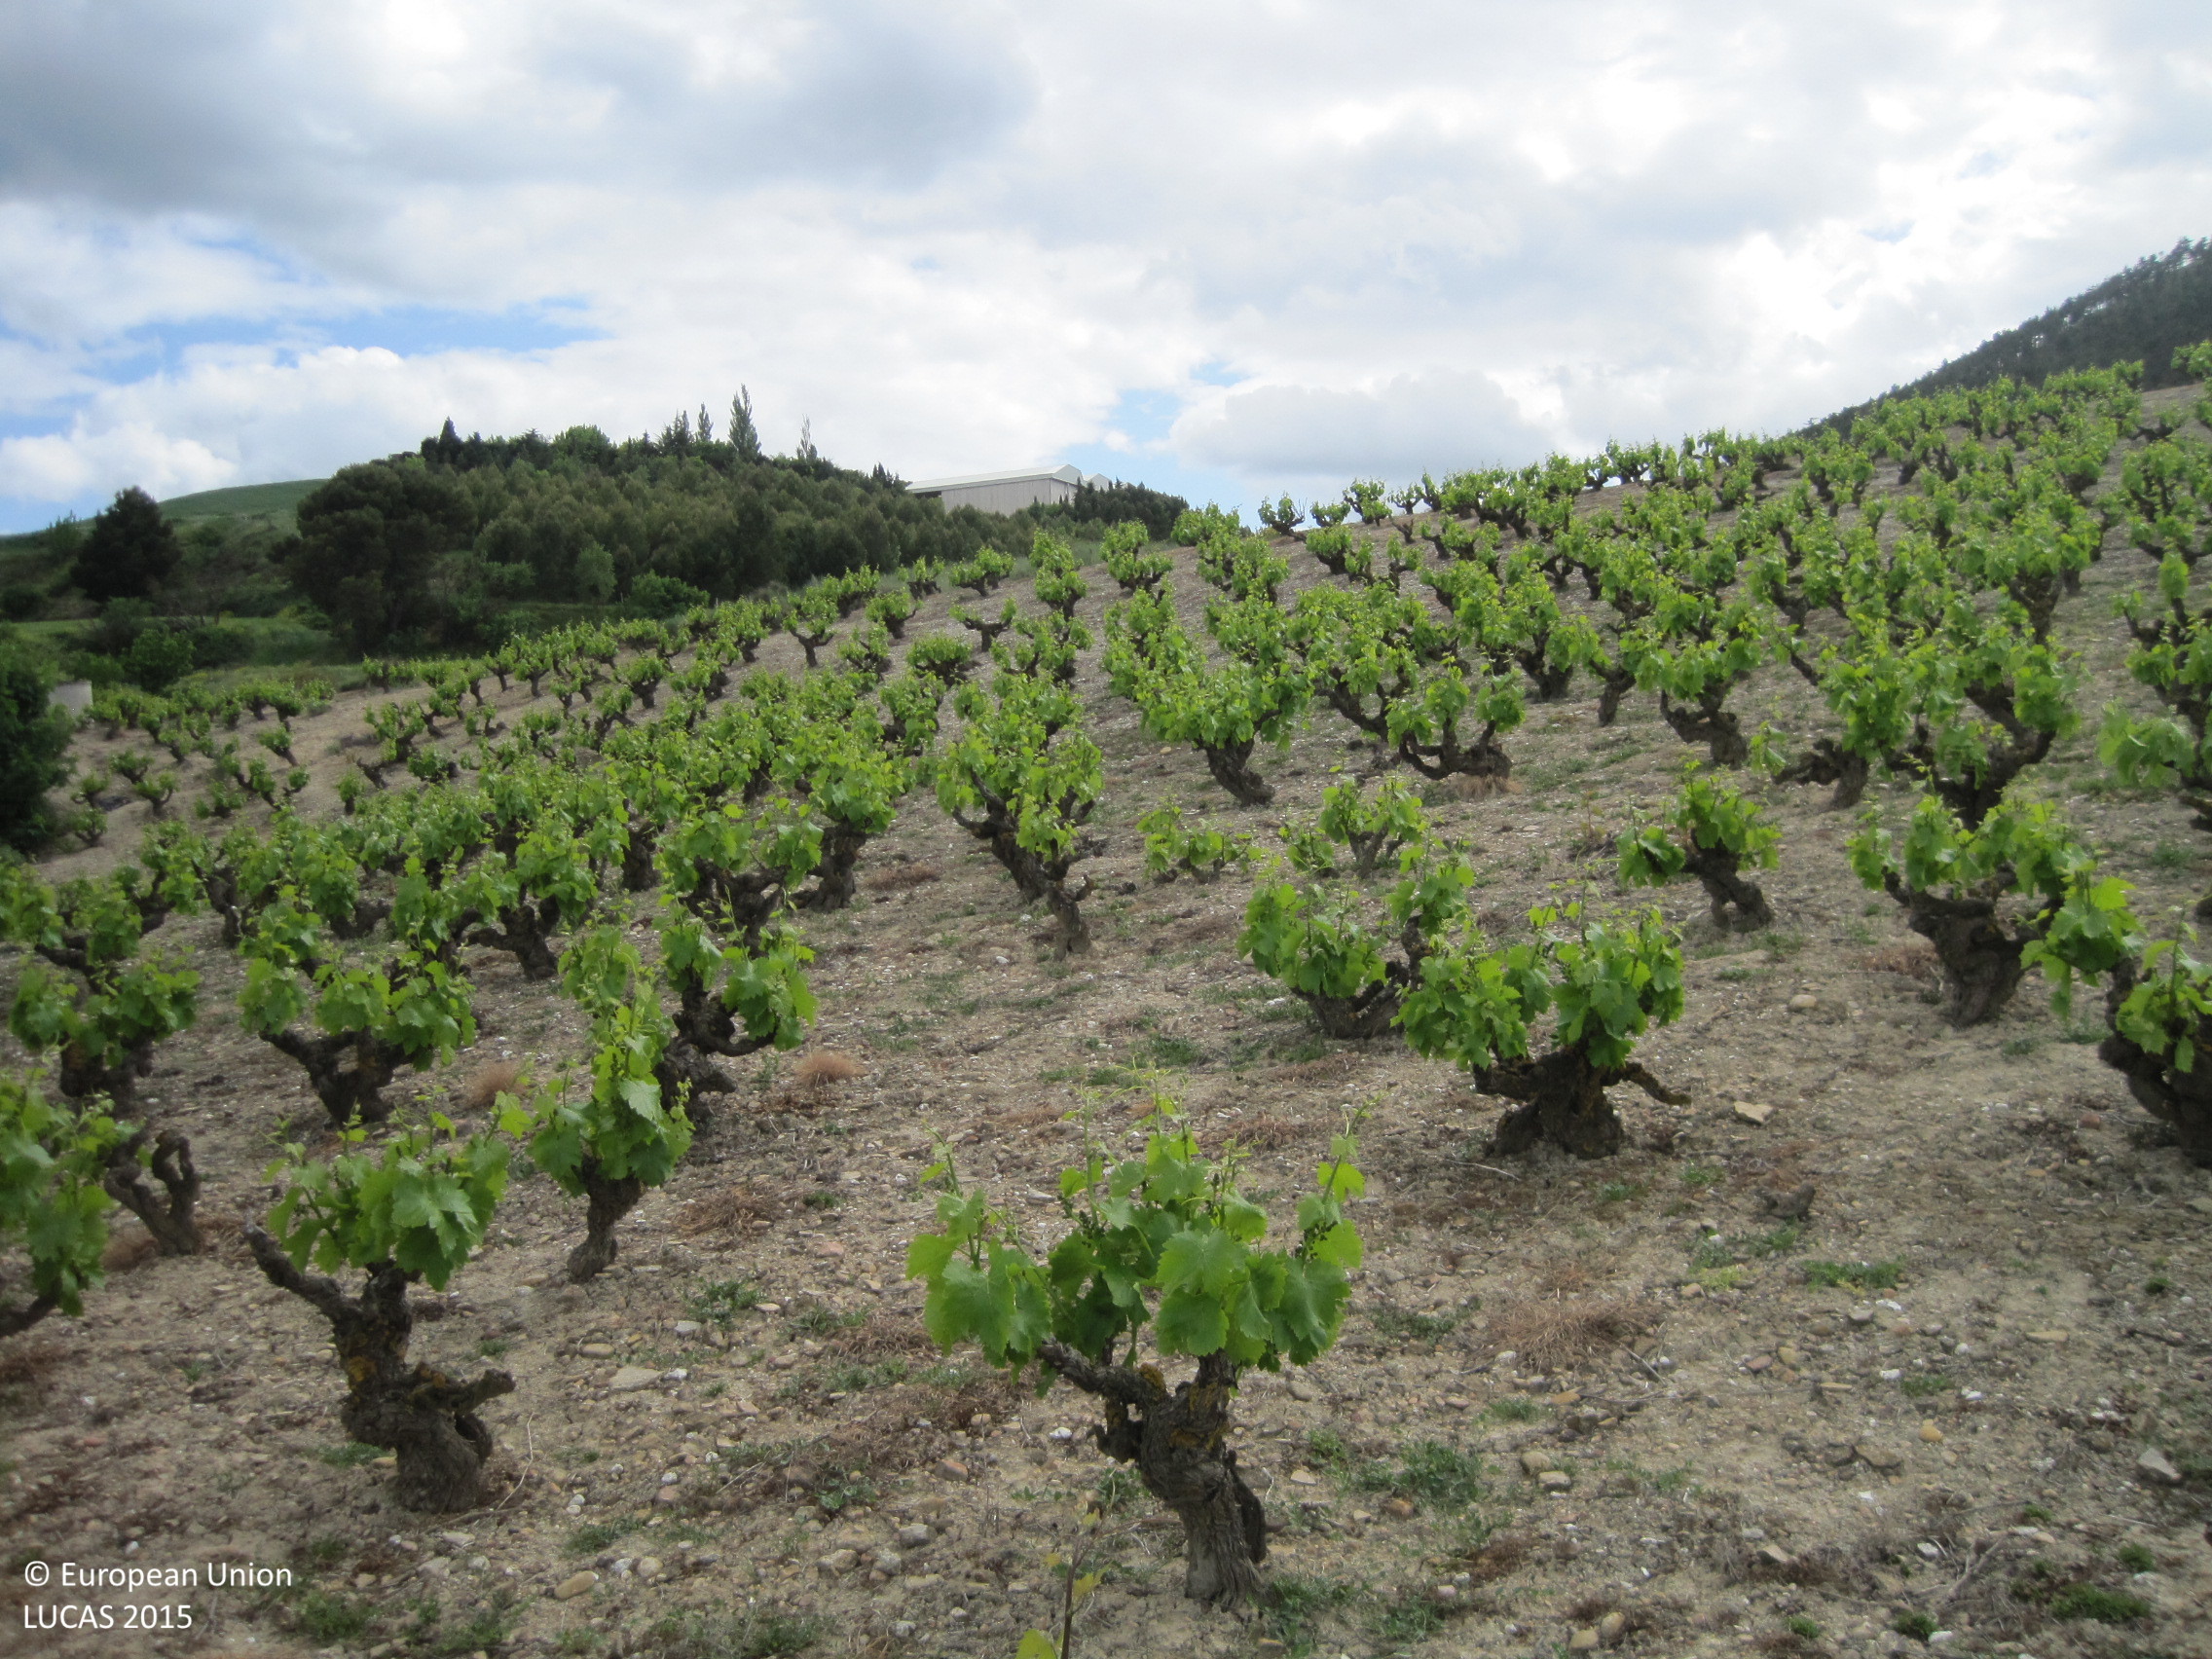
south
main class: Cropland
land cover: Vineyards
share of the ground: 10 - 25 %
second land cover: Other bare soil
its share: > 75 %
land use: Agriculture (excluding fallow land and kitchen gardens)
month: May
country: ES
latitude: 42.6645
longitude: -1.7144
